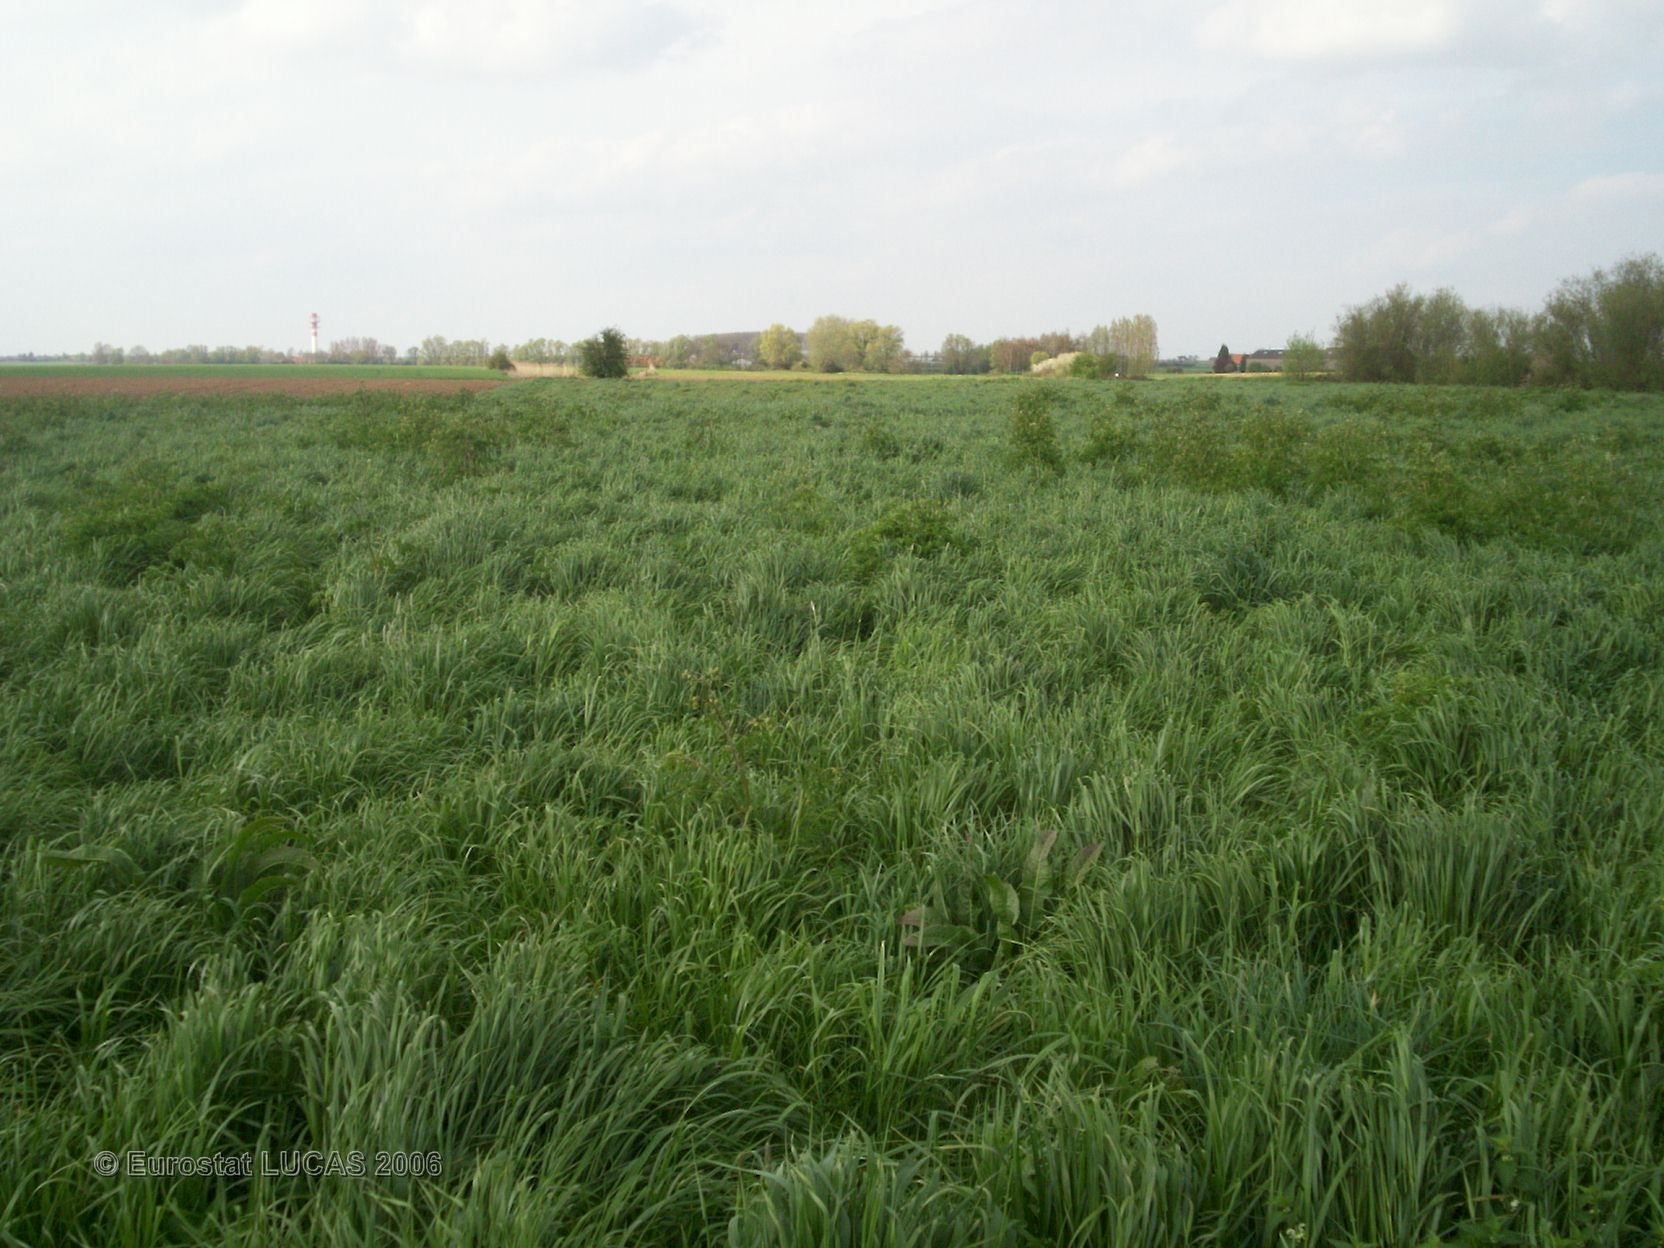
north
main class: Grassland
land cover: Grassland without tree/shrub cover
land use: Agriculture (excluding fallow land and kitchen gardens)
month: May
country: FR
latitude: 50.7546
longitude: 2.5742
